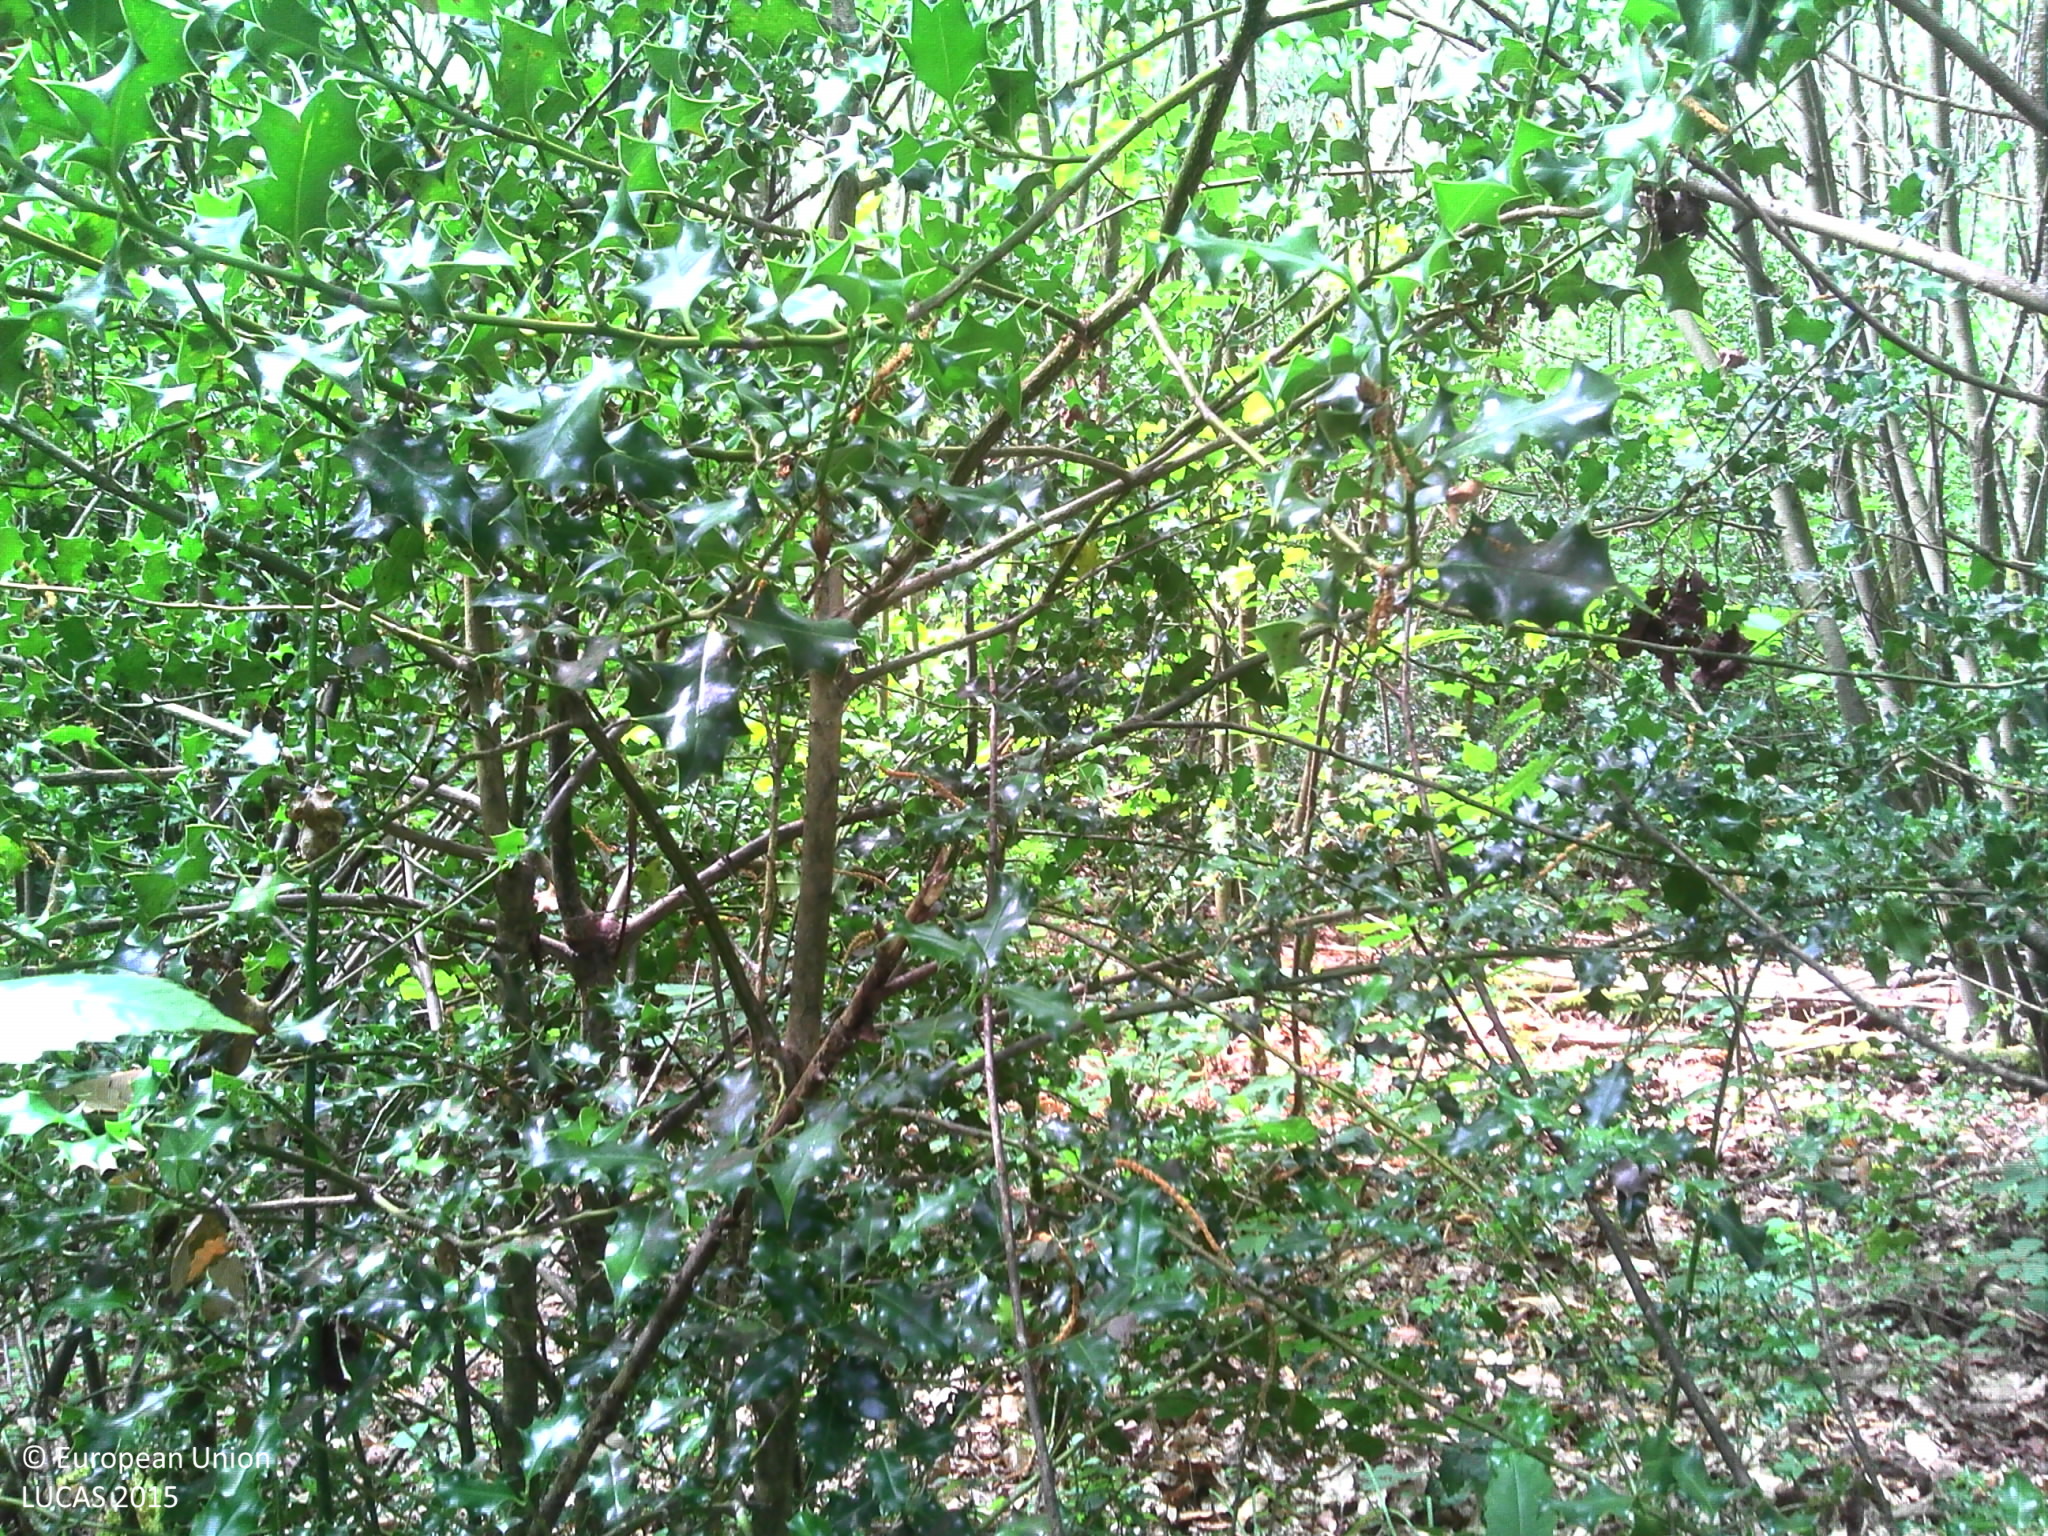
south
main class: Woodland
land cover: Broadleaved woodland
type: acidophilous oak and oak-birch forest
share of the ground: > 75 %
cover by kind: broadleaved forest trees 95 %, herbaceous plants 5 %
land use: Forestry
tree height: > 5 m
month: July
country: FR
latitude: 47.5856
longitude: -1.8151
